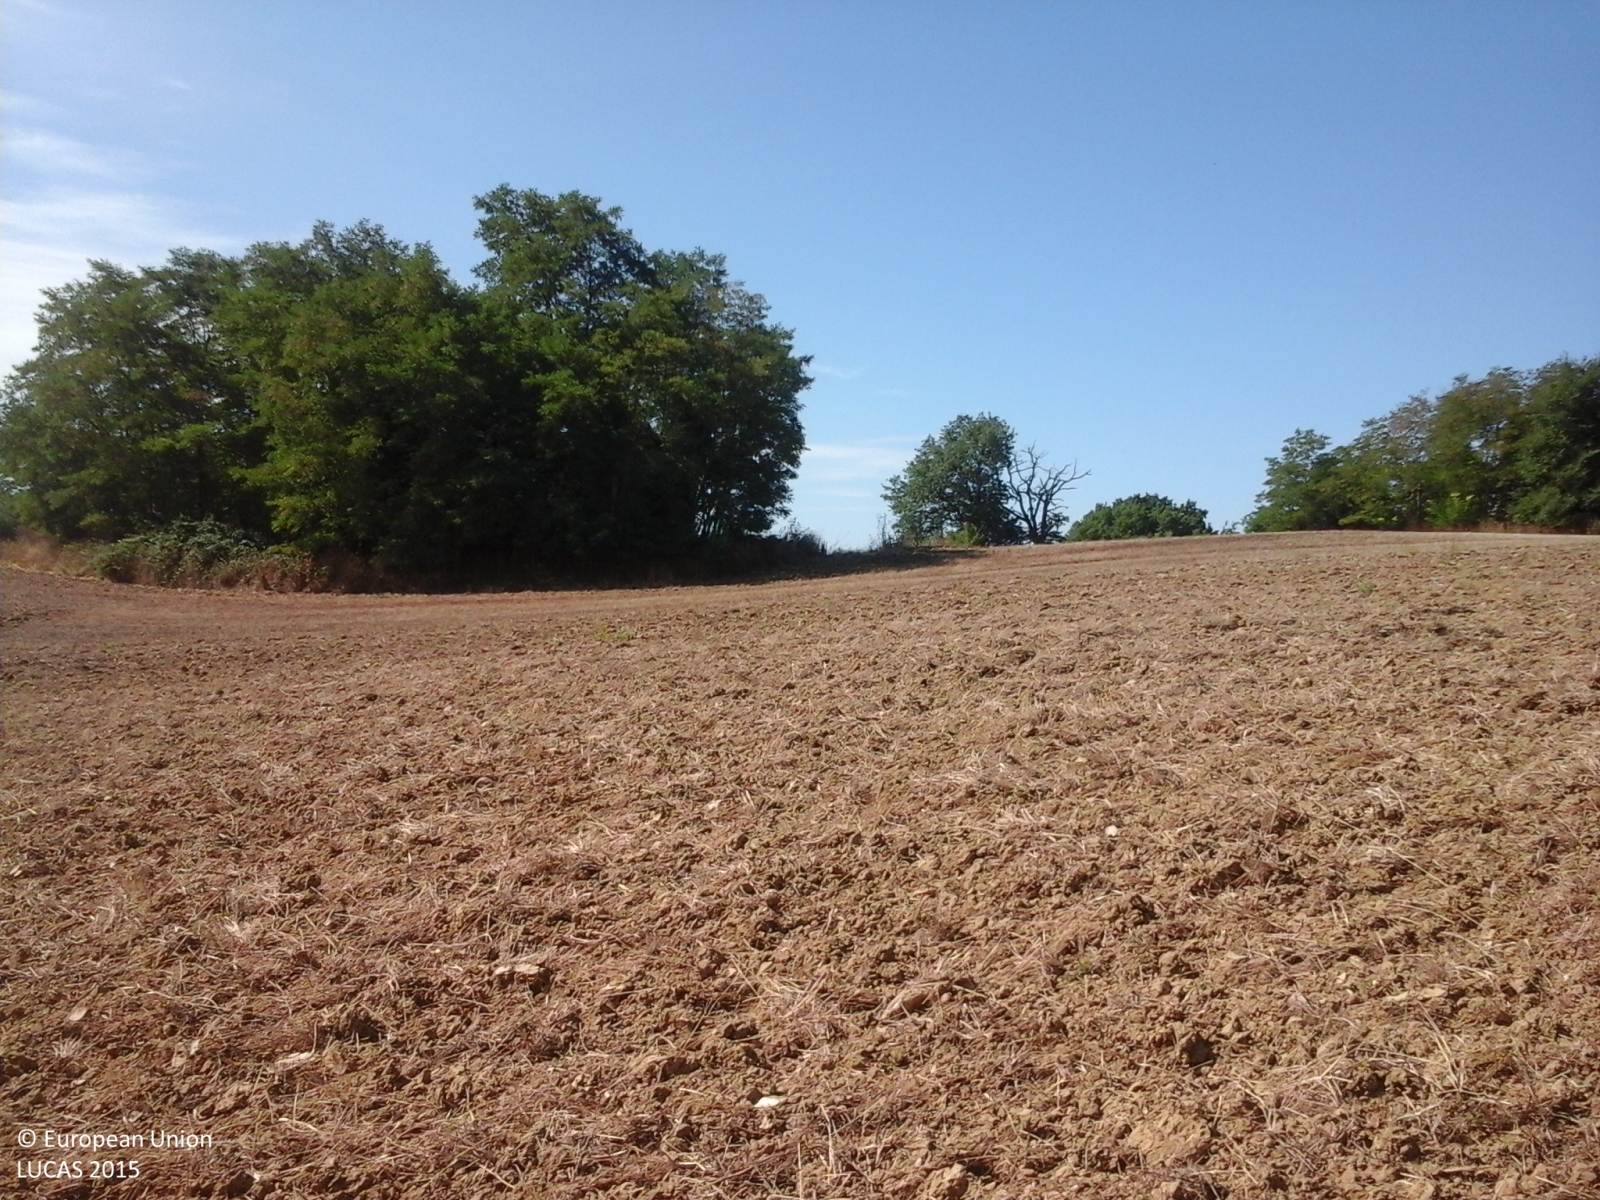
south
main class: Cropland
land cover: Other leguminous and mixtures for fodder
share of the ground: 10 - 25 %
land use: Agriculture (excluding fallow land and kitchen gardens)
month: August
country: IT
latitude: 43.2921
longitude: 11.5608
